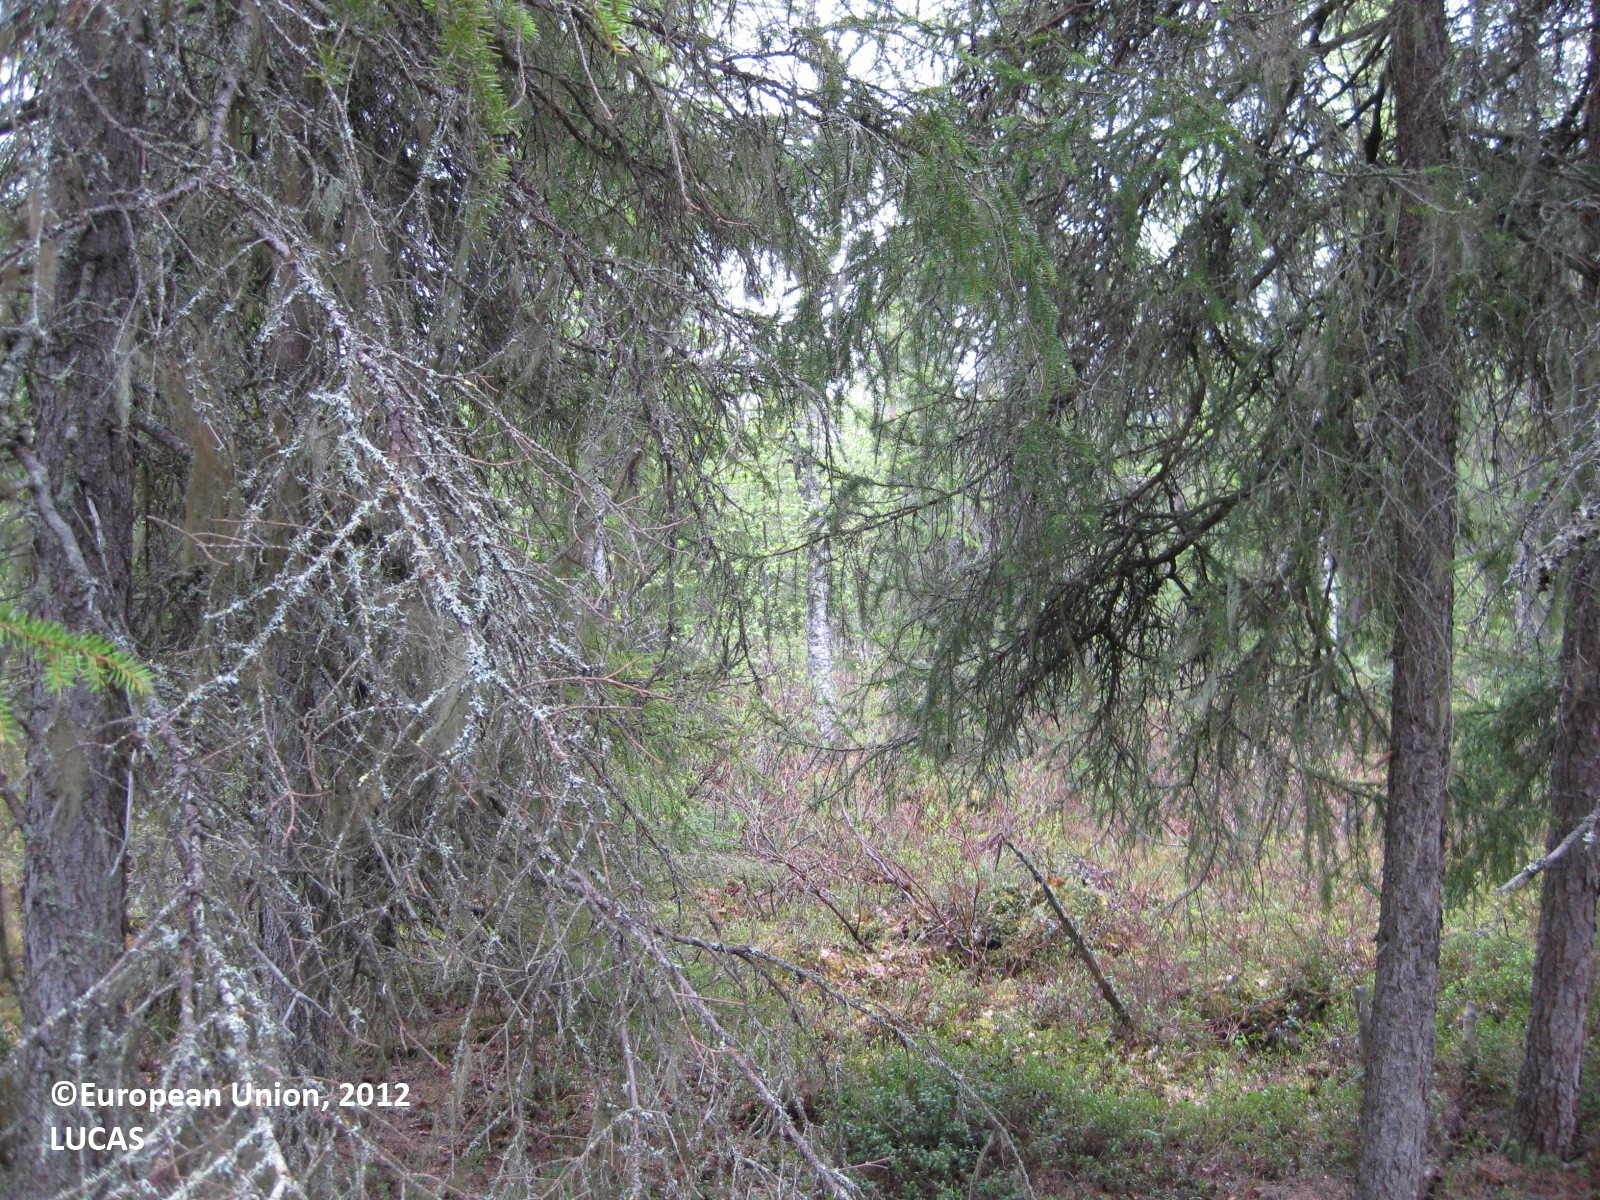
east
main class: Woodland
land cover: Spruce dominated mixed woodland
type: boreal forest
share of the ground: > 75 %
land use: Forestry
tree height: > 5 m
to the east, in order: Spruce dominated mixed woodland; Ditches and canals; Spruce dominated mixed woodland; Pine dominated coniferous woodland; Ditches and canals; Pine dominated mixed woodland; Ditches and canals; Pine dominated mixed woodland; Ditches and canals; Pine dominated mixed woodland; Ditches and canals; Pine dominated mixed woodland
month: June
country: FI
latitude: 65.3277
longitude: 29.3239
